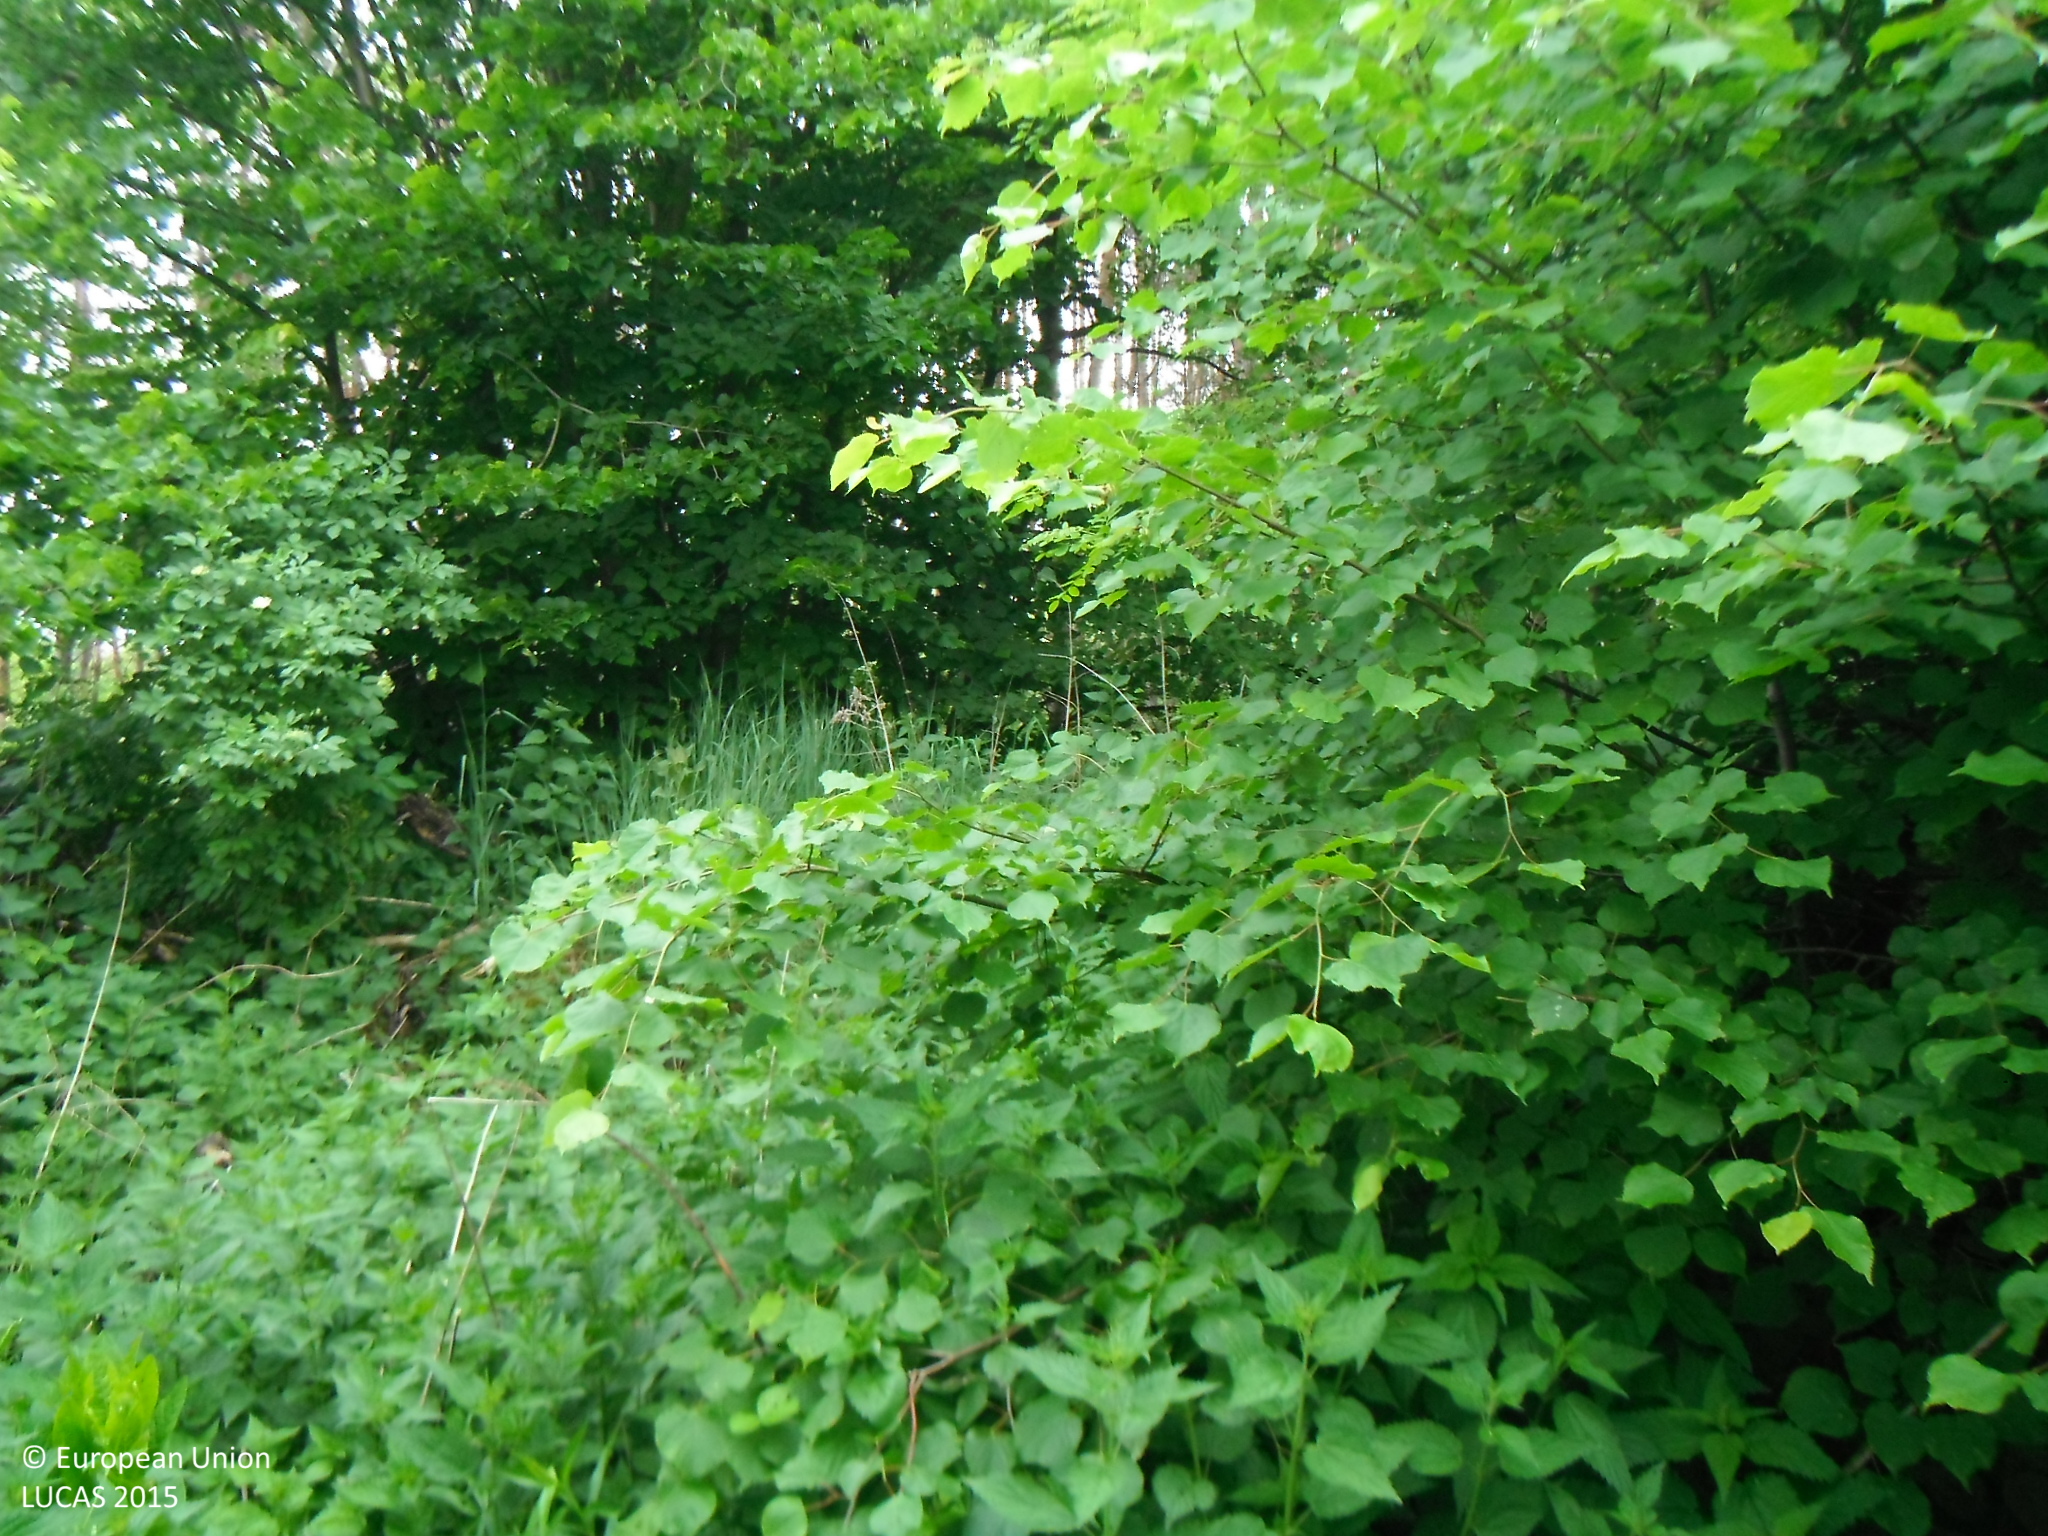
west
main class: Shrubland
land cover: Shrubland with sparse tree cover
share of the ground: > 75 %
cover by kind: herbaceous plants 80 %, shrubs 15 %, broadleaved forest trees 5 %
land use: Abandoned areas
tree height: < 5 m
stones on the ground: < 10 %
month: May
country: SK
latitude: 48.3971
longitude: 17.0178
